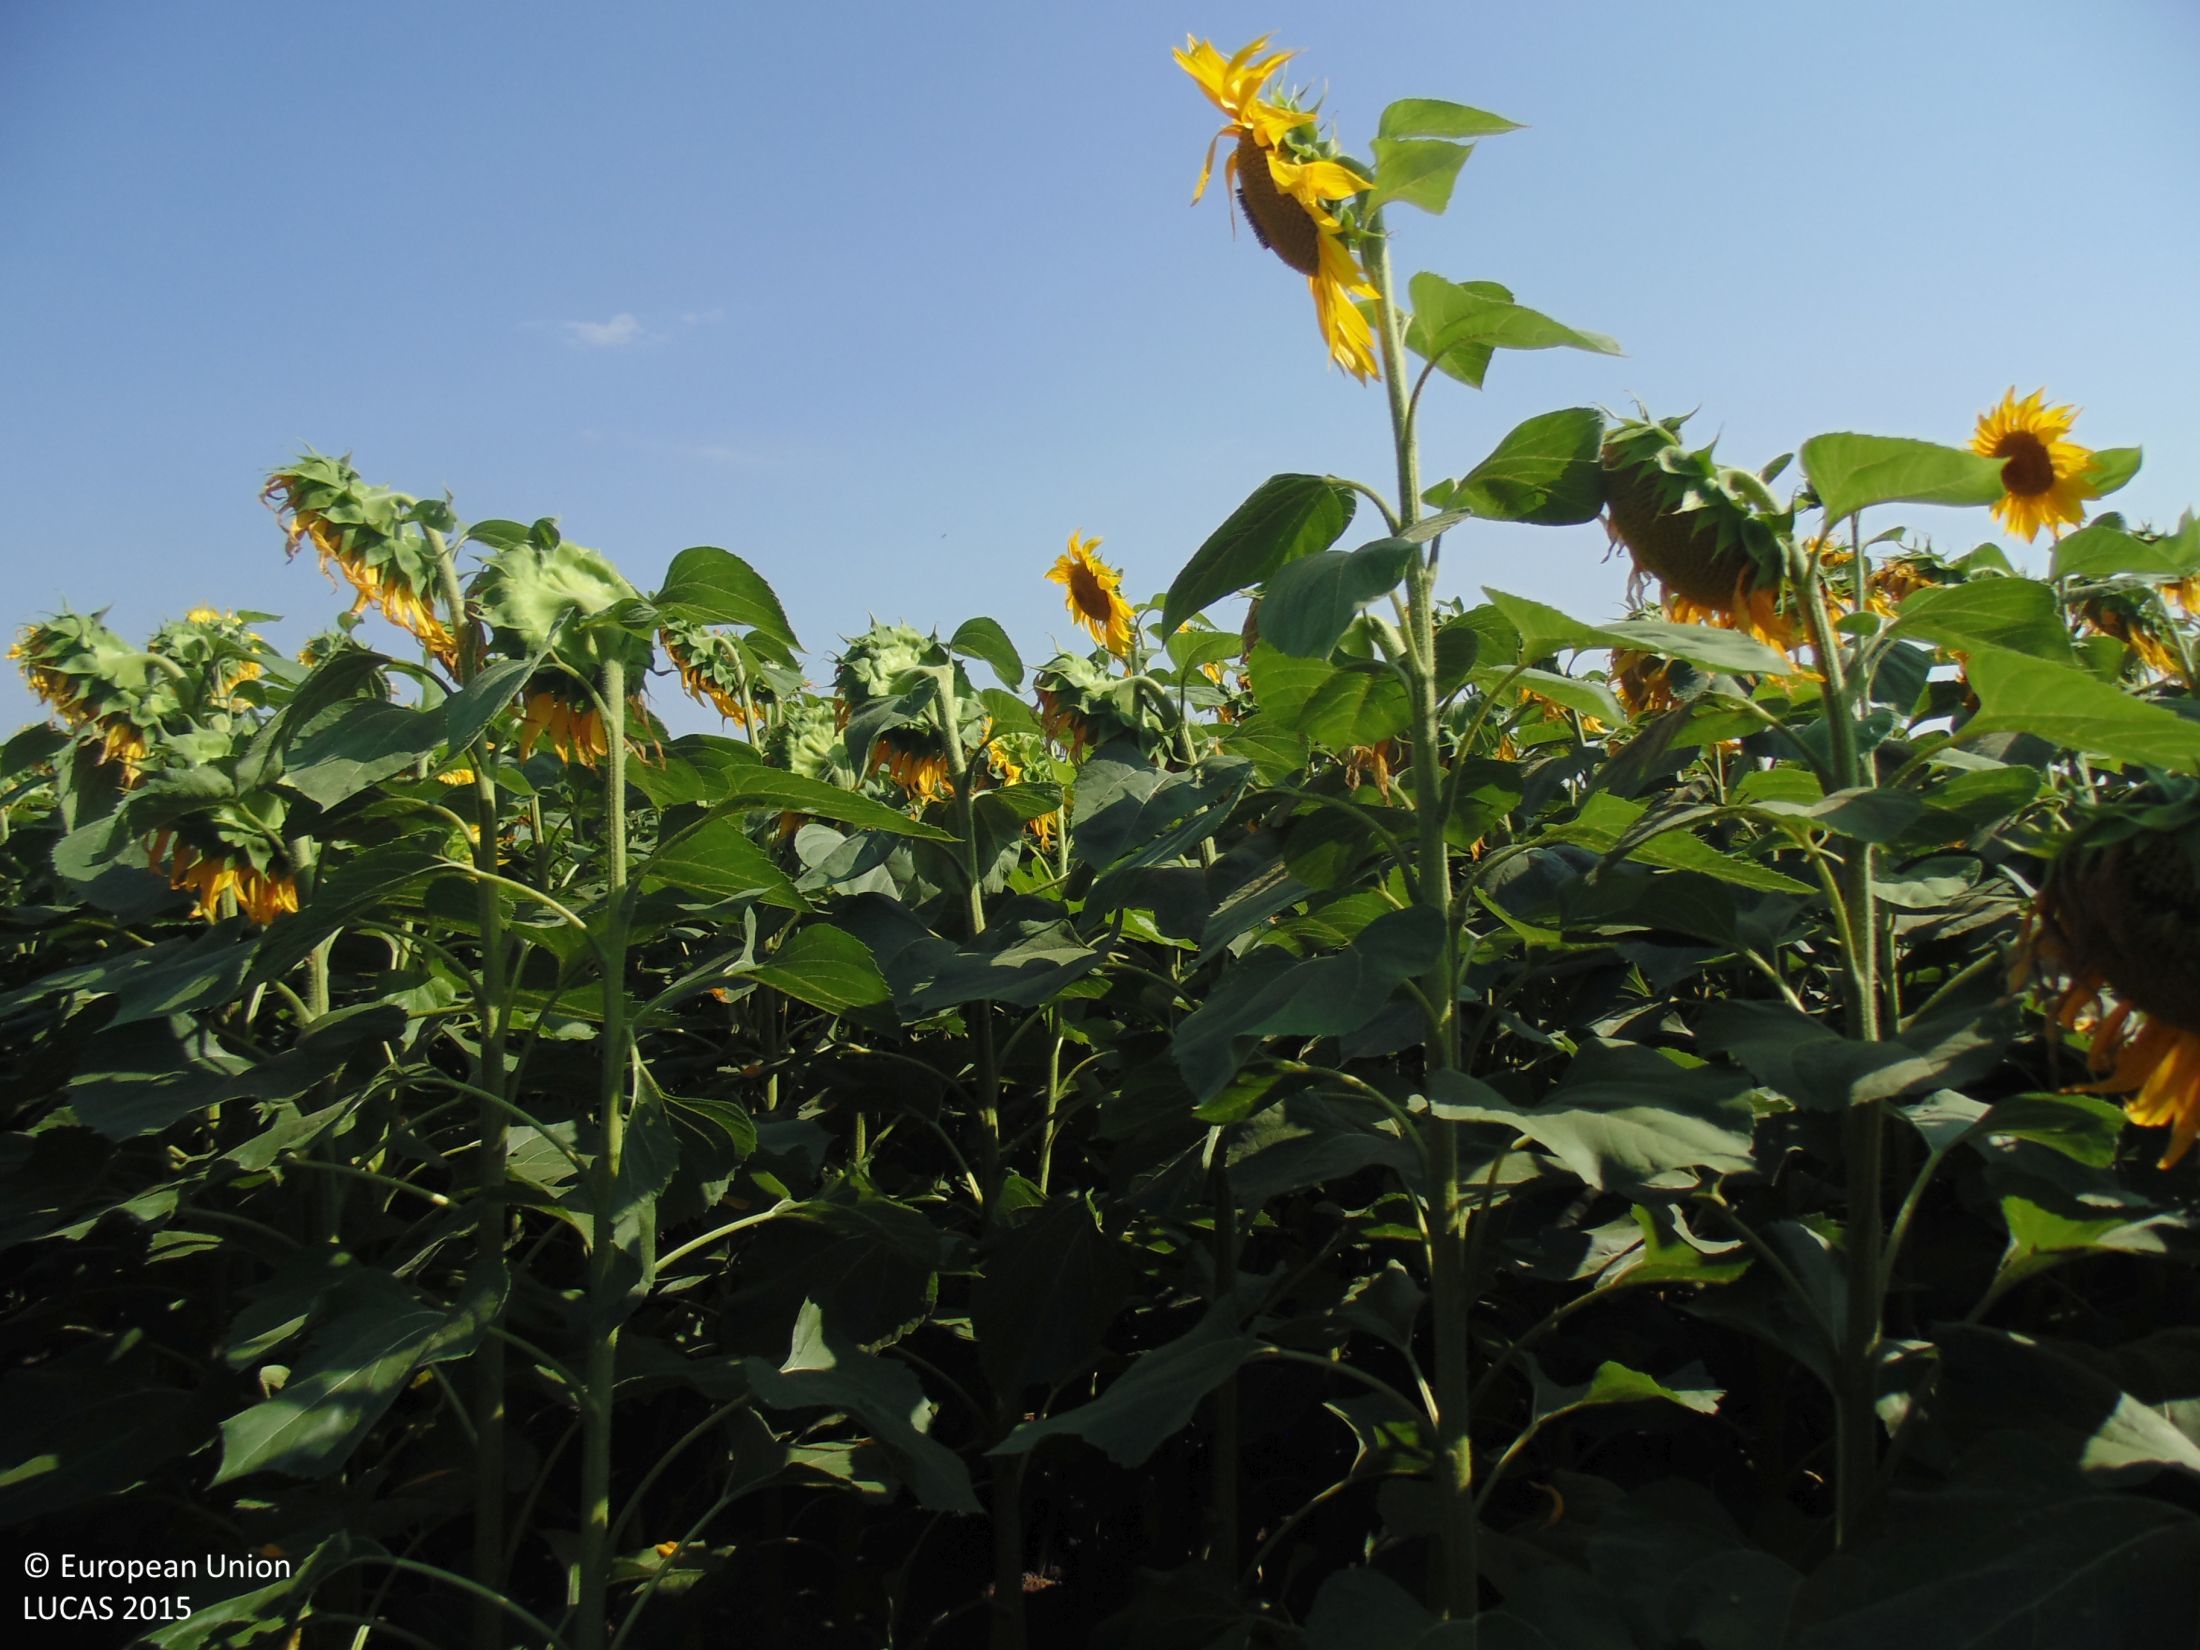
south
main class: Cropland
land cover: Sunflower
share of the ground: > 75 %
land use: Agriculture (excluding fallow land and kitchen gardens)
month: July
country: BG
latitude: 43.4999
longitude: 27.9915
